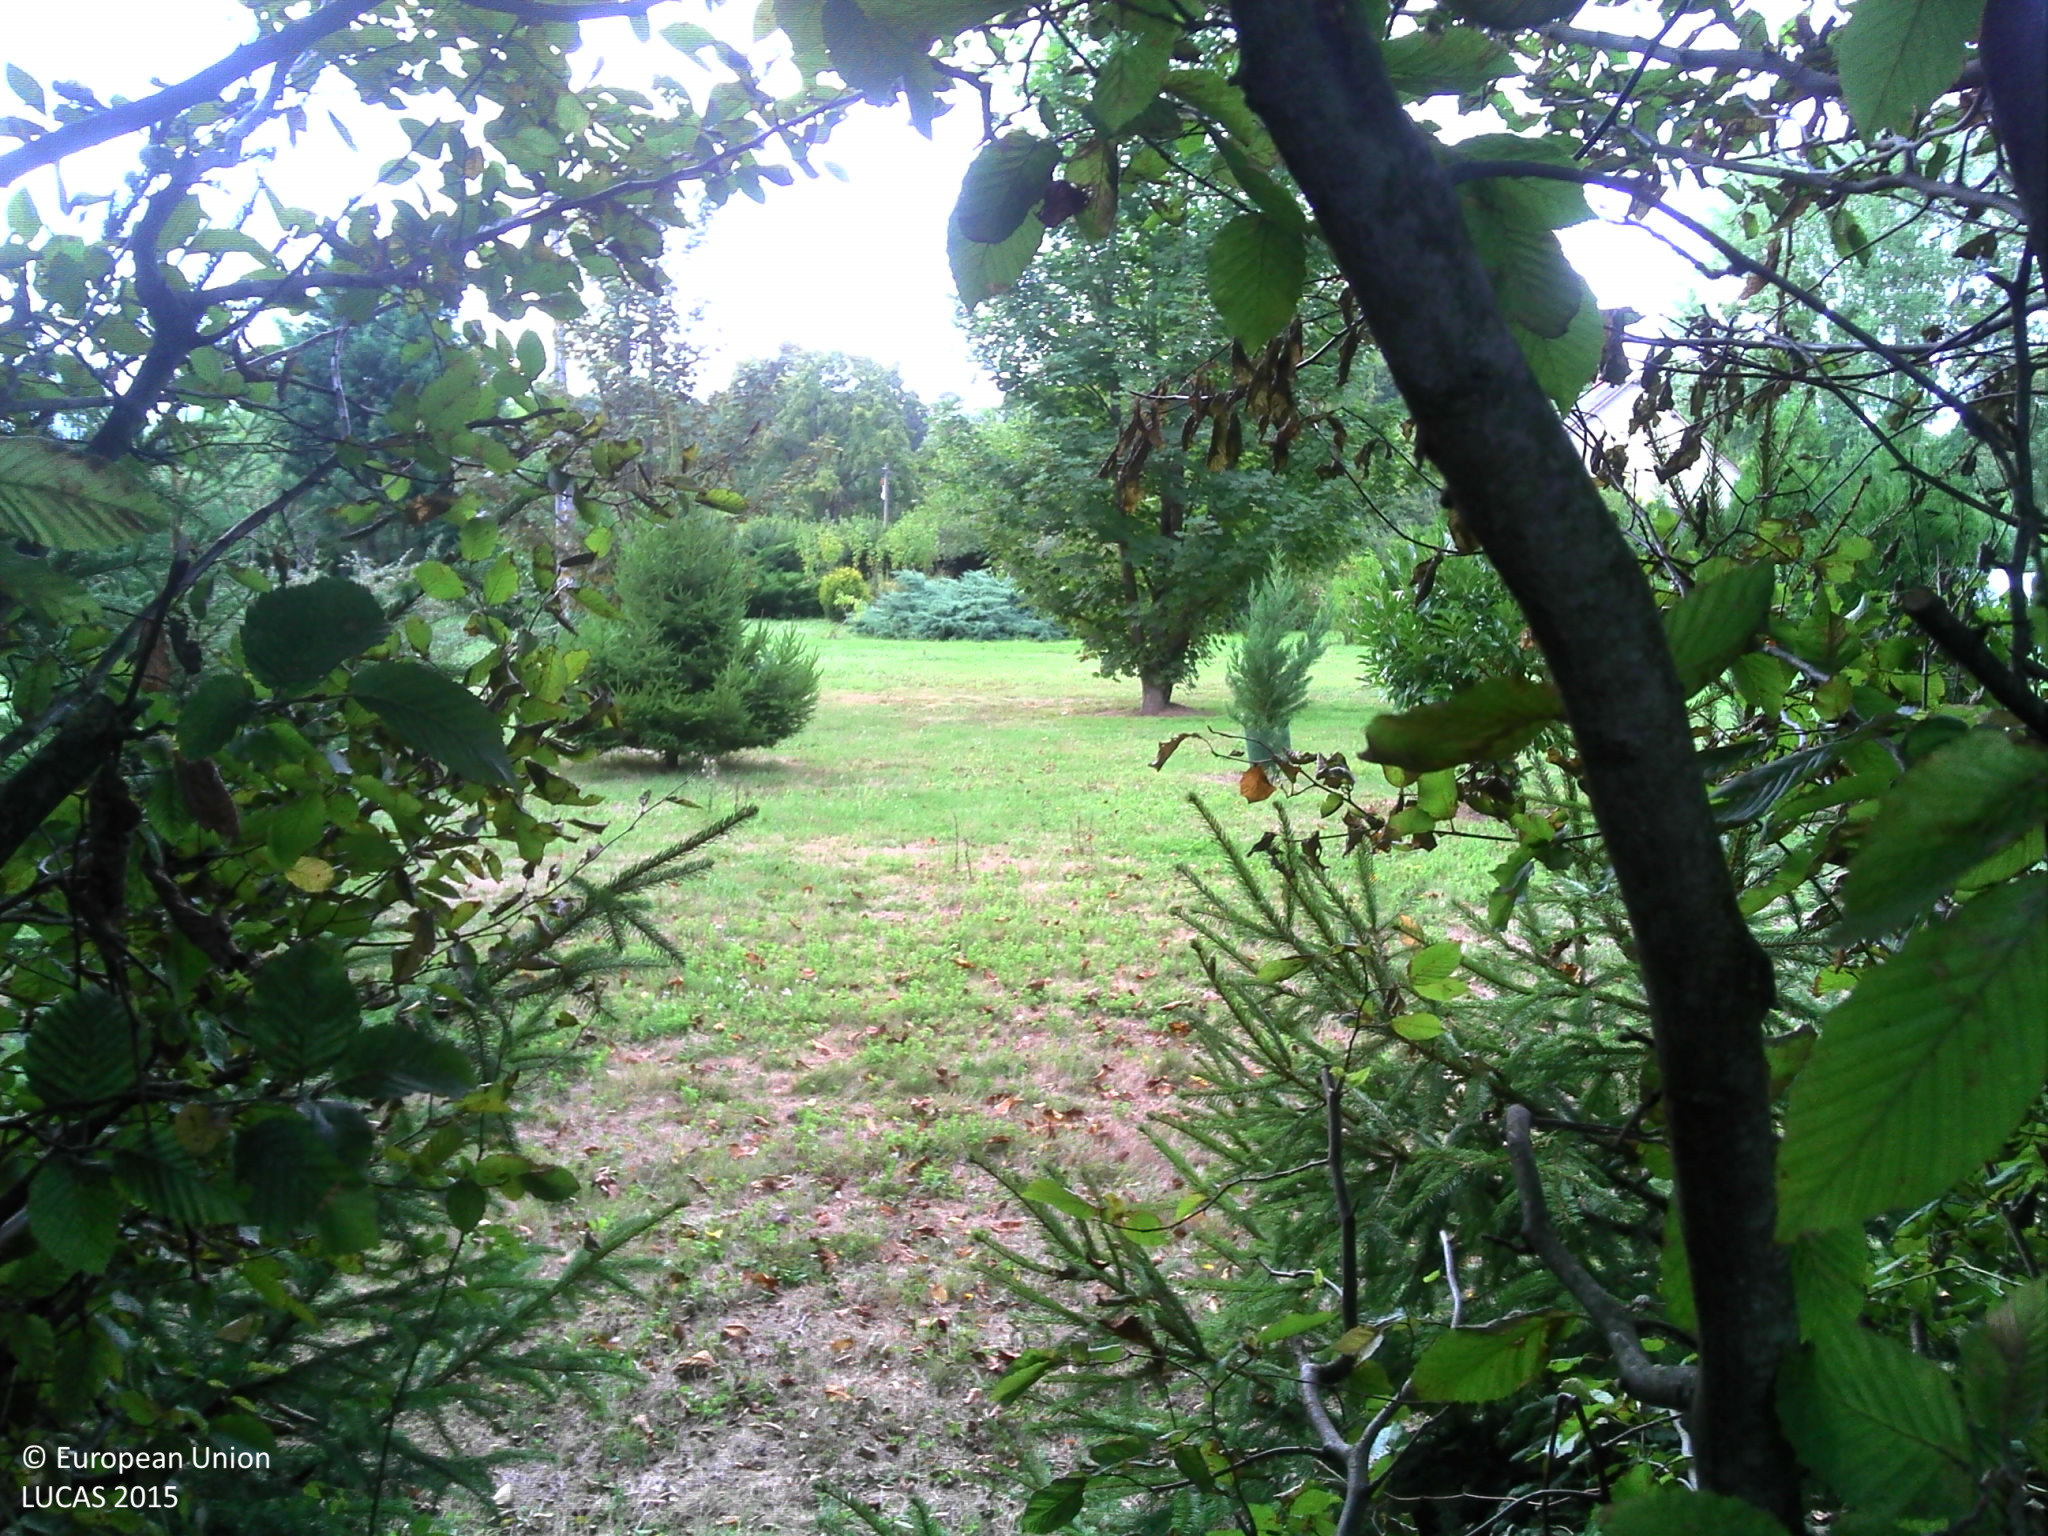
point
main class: Grassland
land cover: Grassland with sparse tree/shrub cover
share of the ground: > 75 %
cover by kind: herbaceous plants 95 %, coniferous forest trees 5 %
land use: Residential
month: September
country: FR
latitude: 46.9843
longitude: 1.4286
